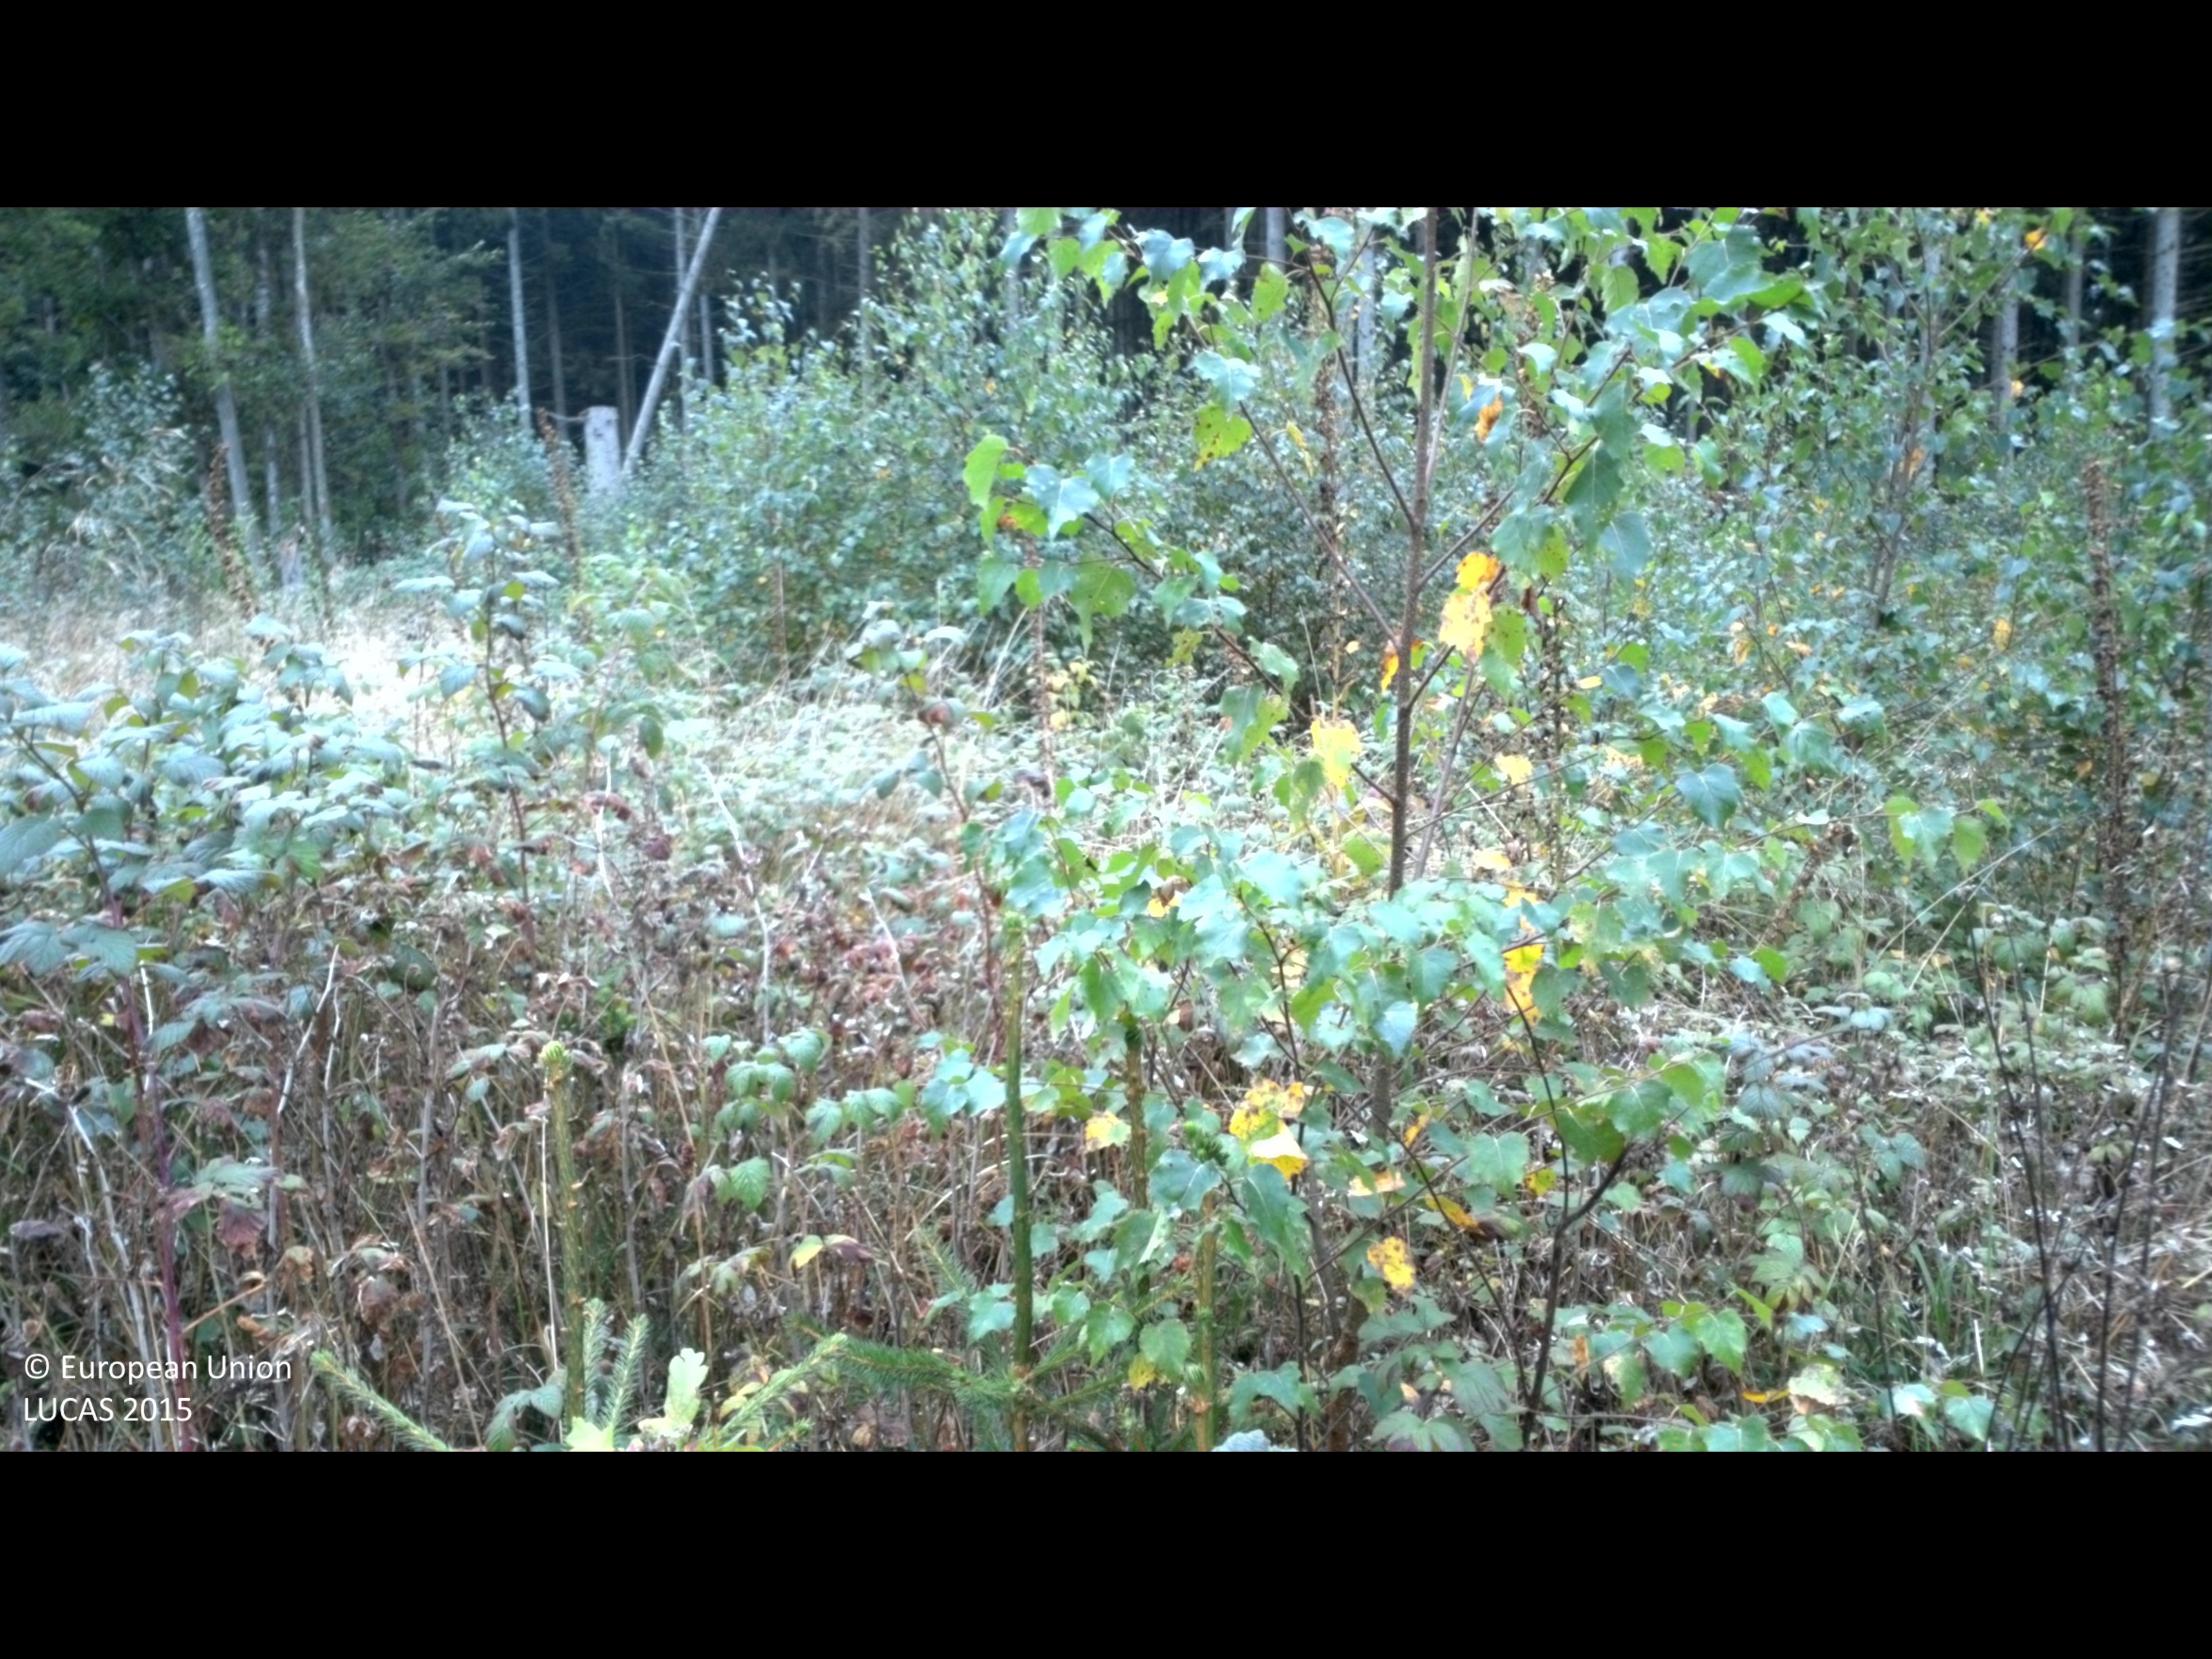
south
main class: Woodland
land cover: Broadleaved woodland
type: hemiboreal forest and nemoral coniferous forest and mixed broadleaved-coniferous forest
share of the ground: 25 - 50 %
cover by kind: broadleaved forest trees 50 %, herbaceous plants 30 %, shrubs 20 %
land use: Forestry
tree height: < 5 m
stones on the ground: < 10 %
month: September
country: SE
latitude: 56.0167
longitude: 14.0243
